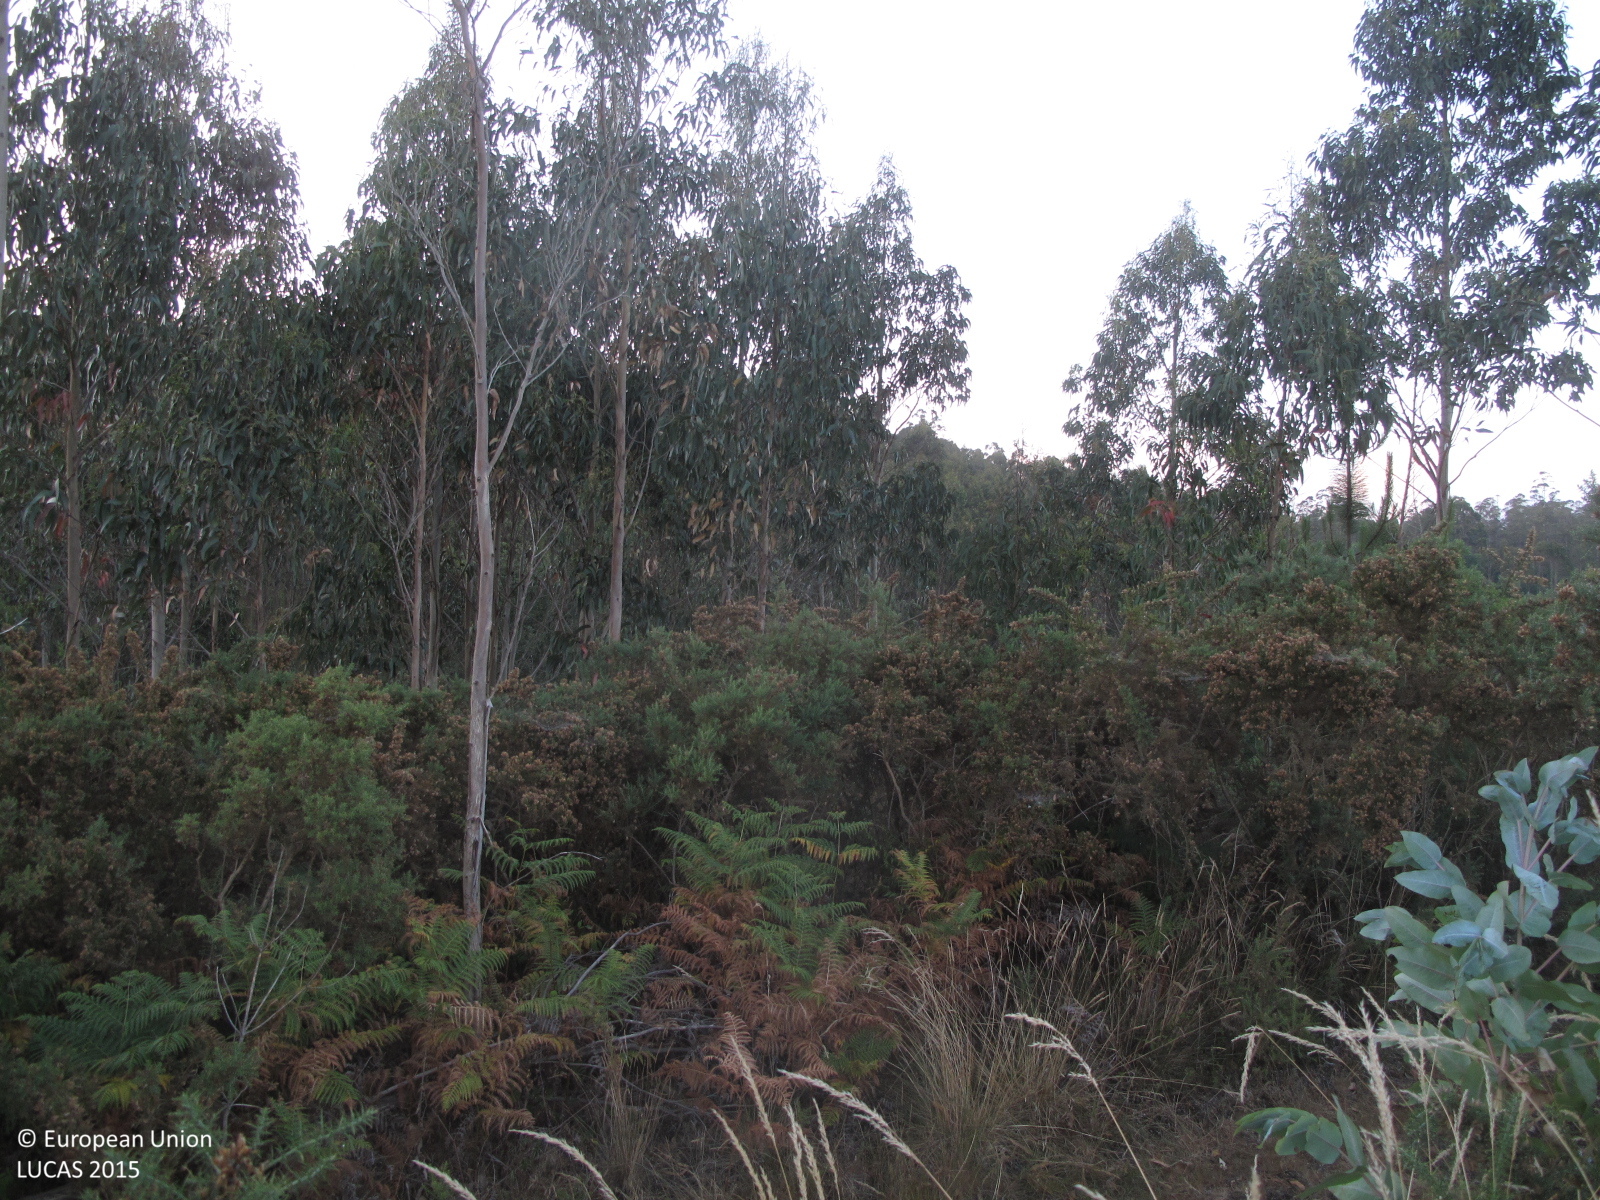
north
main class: Woodland
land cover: Broadleaved woodland
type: exotic forest
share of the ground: 10 - 25 %
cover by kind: shrubs 60 %, broadleaved forest trees 20 %, herbaceous plants 20 %
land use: Forestry
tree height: < 5 m
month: July
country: ES
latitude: 43.5524
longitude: -8.1103
